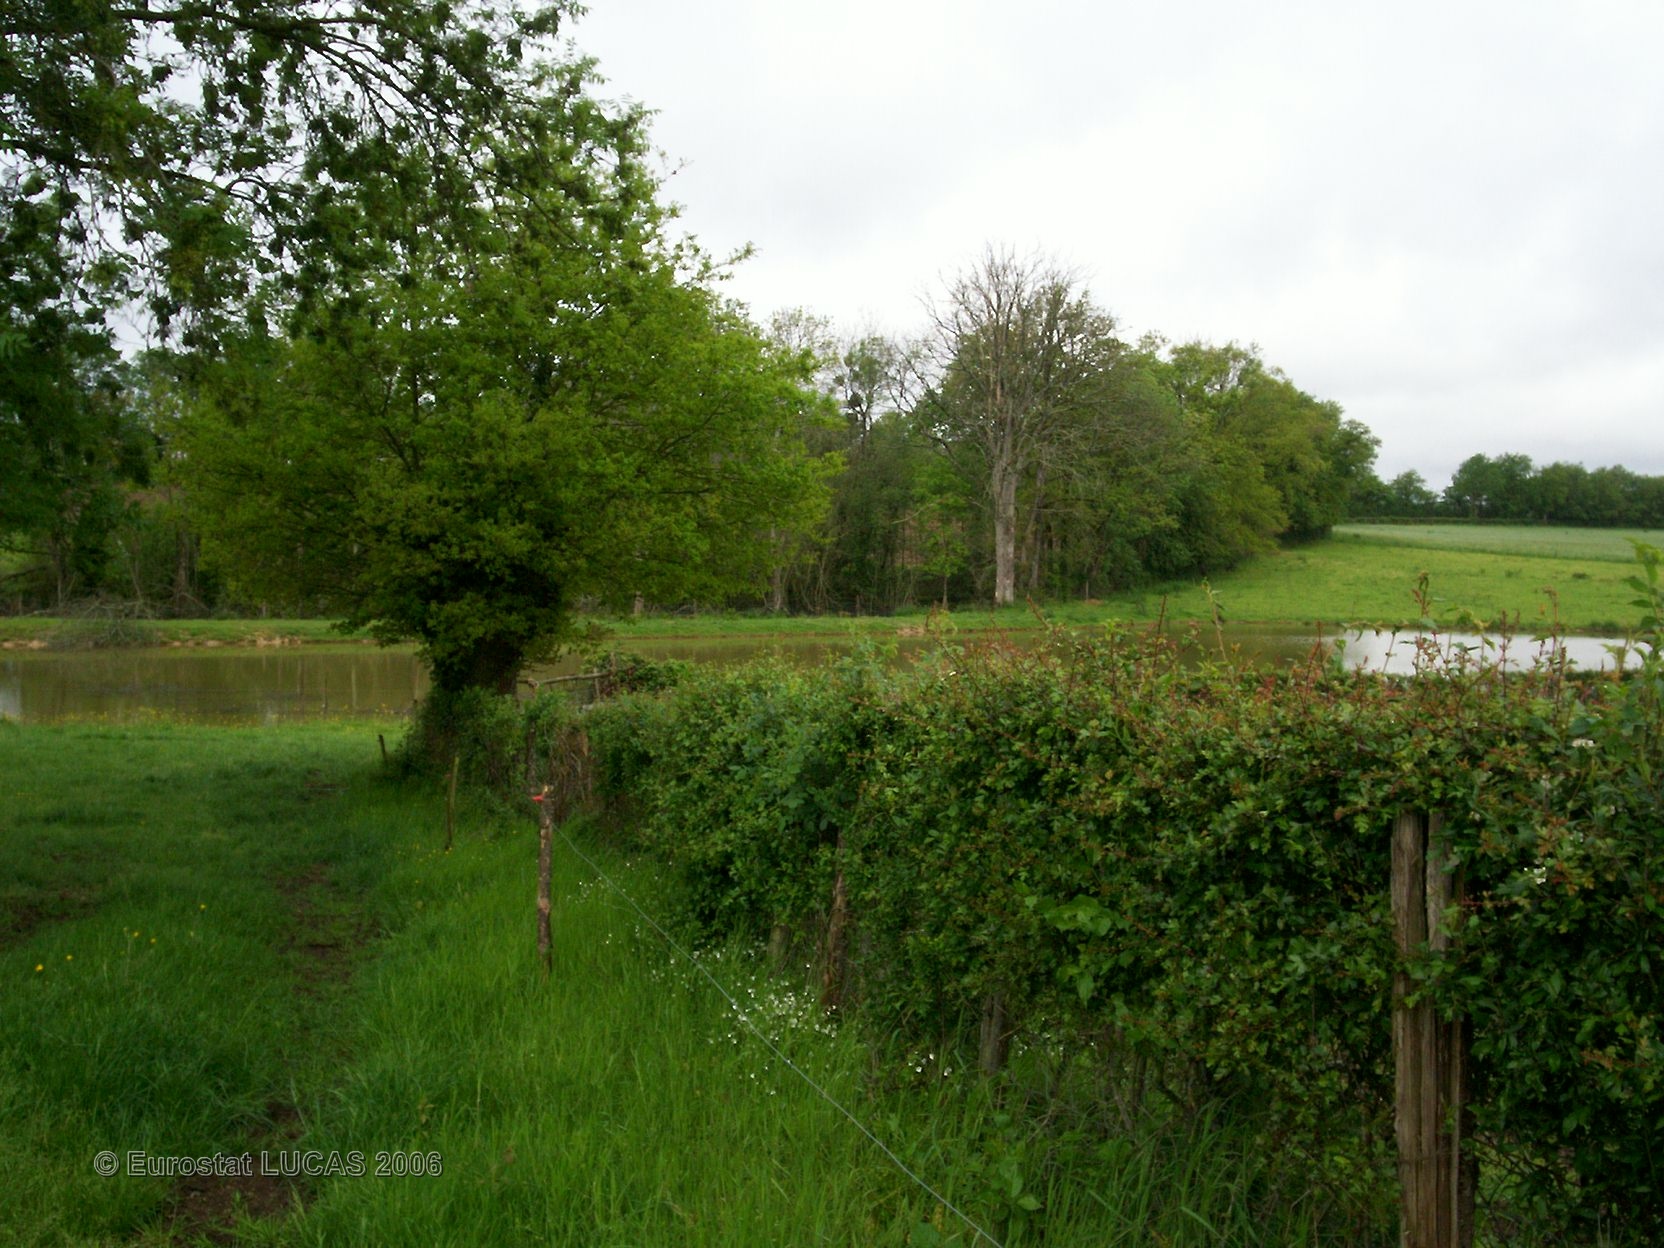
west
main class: Grassland
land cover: Grassland without tree/shrub cover
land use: Agriculture (excluding fallow land and kitchen gardens)
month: May
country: FR
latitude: 46.6885
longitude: -0.2895
